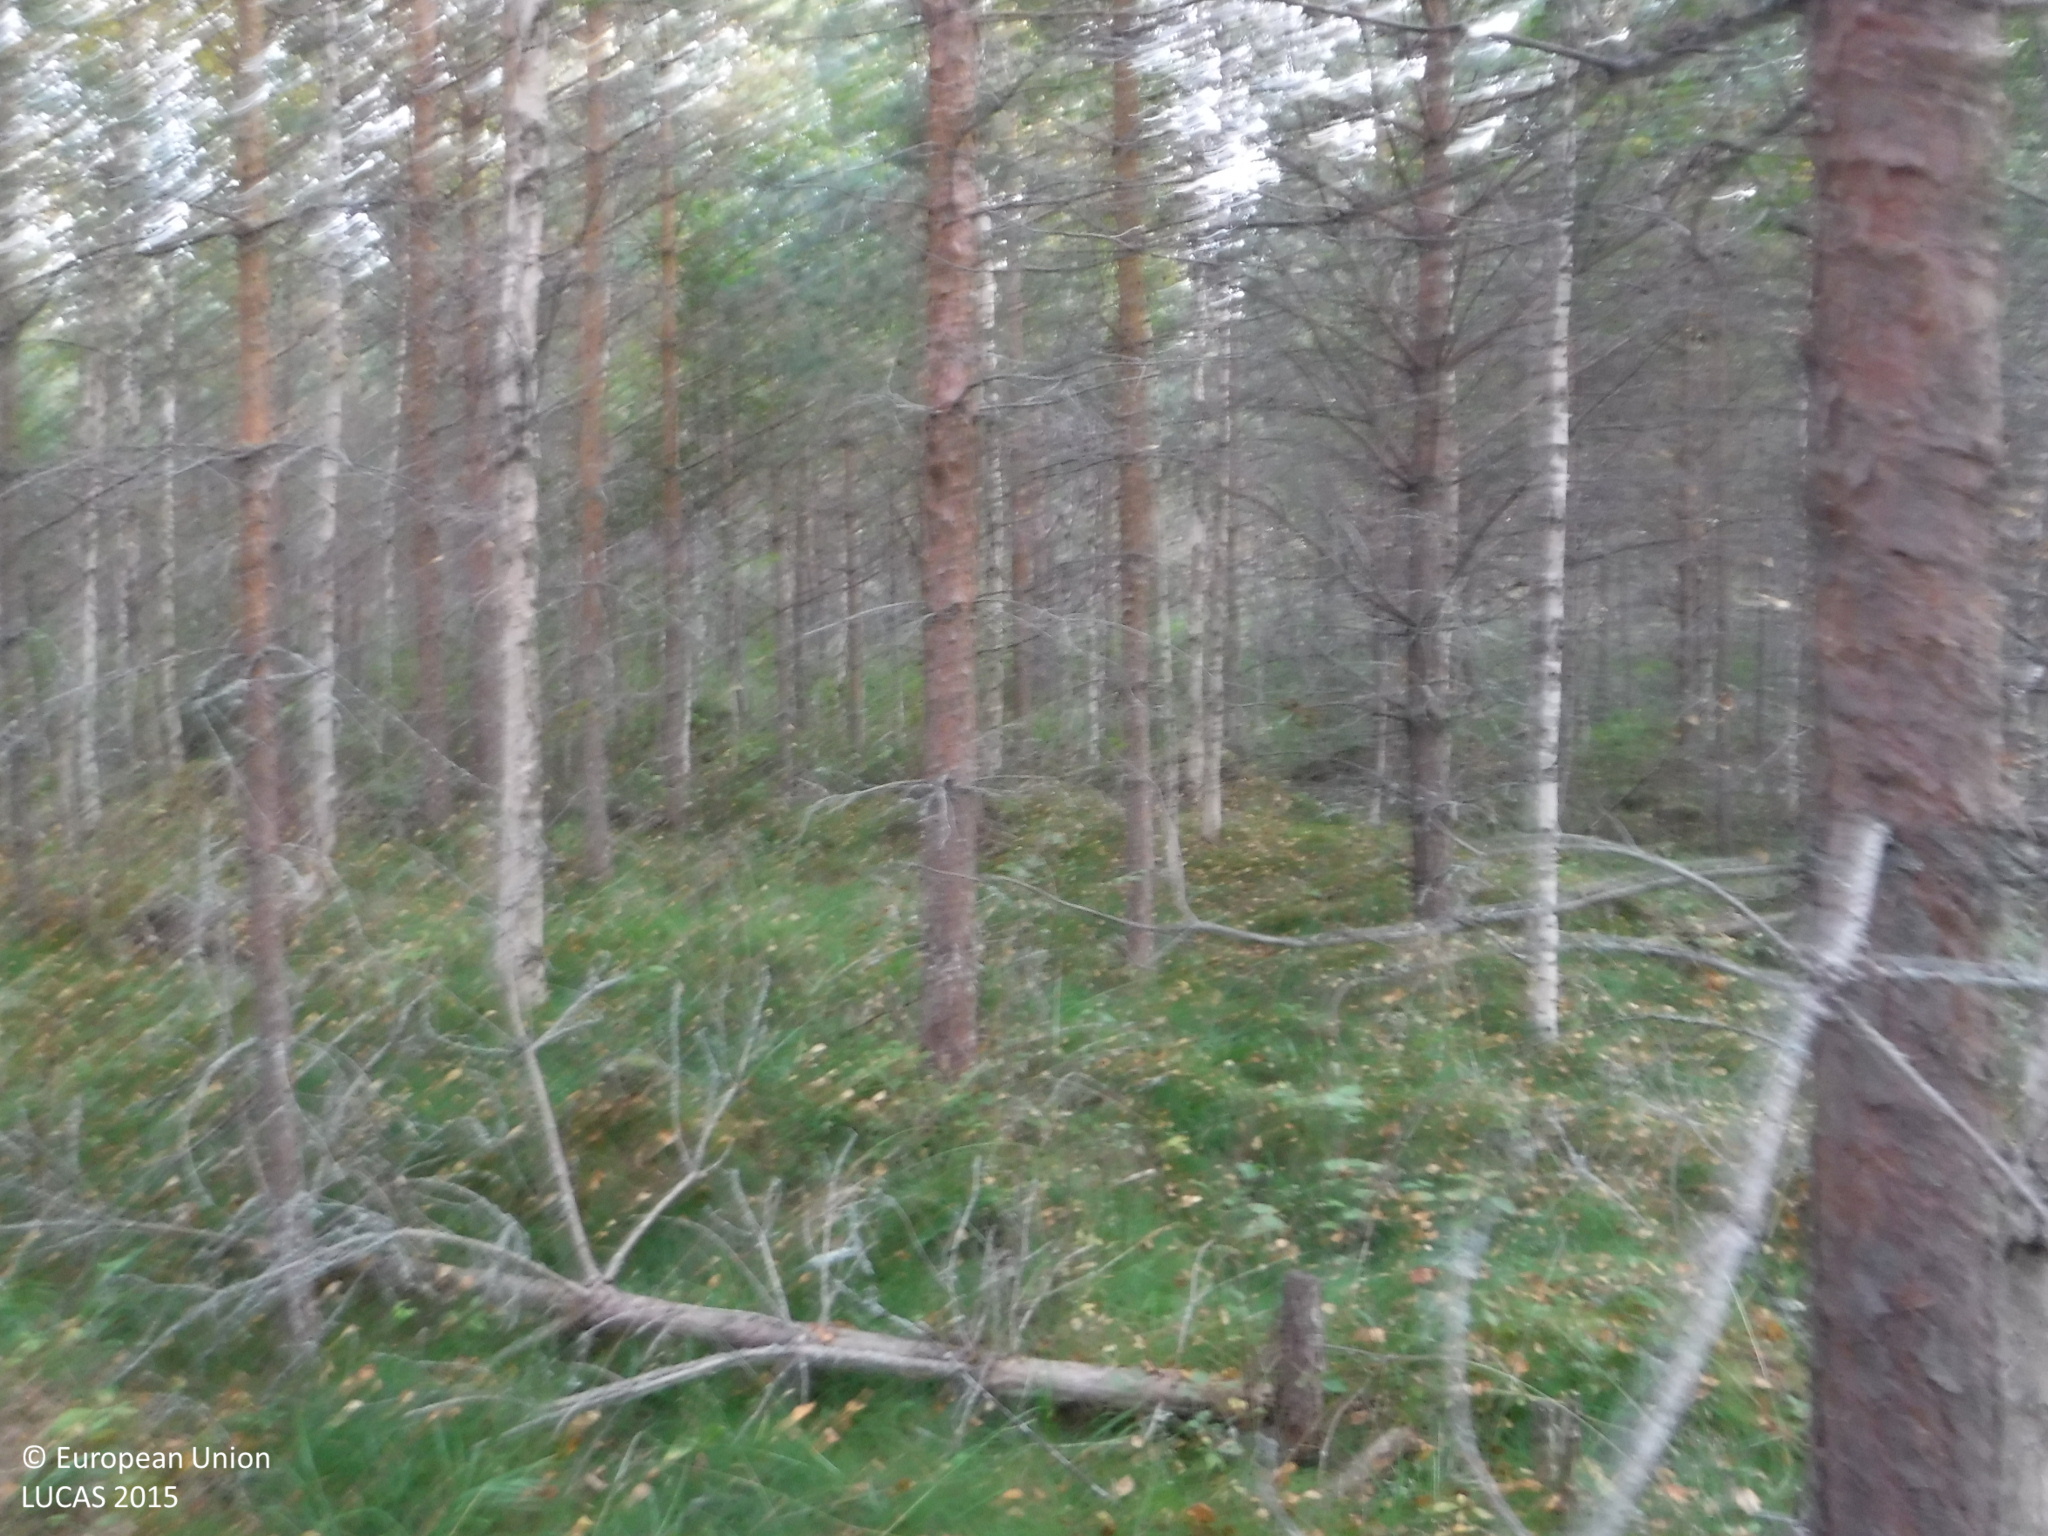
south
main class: Woodland
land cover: Pine dominated mixed woodland
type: boreal forest
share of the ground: > 75 %
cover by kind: coniferous forest trees 40 %, broadleaved forest trees 40 %, herbaceous plants 20 %
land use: Forestry
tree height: > 5 m
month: August
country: FI
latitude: 61.1467
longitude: 23.0218
